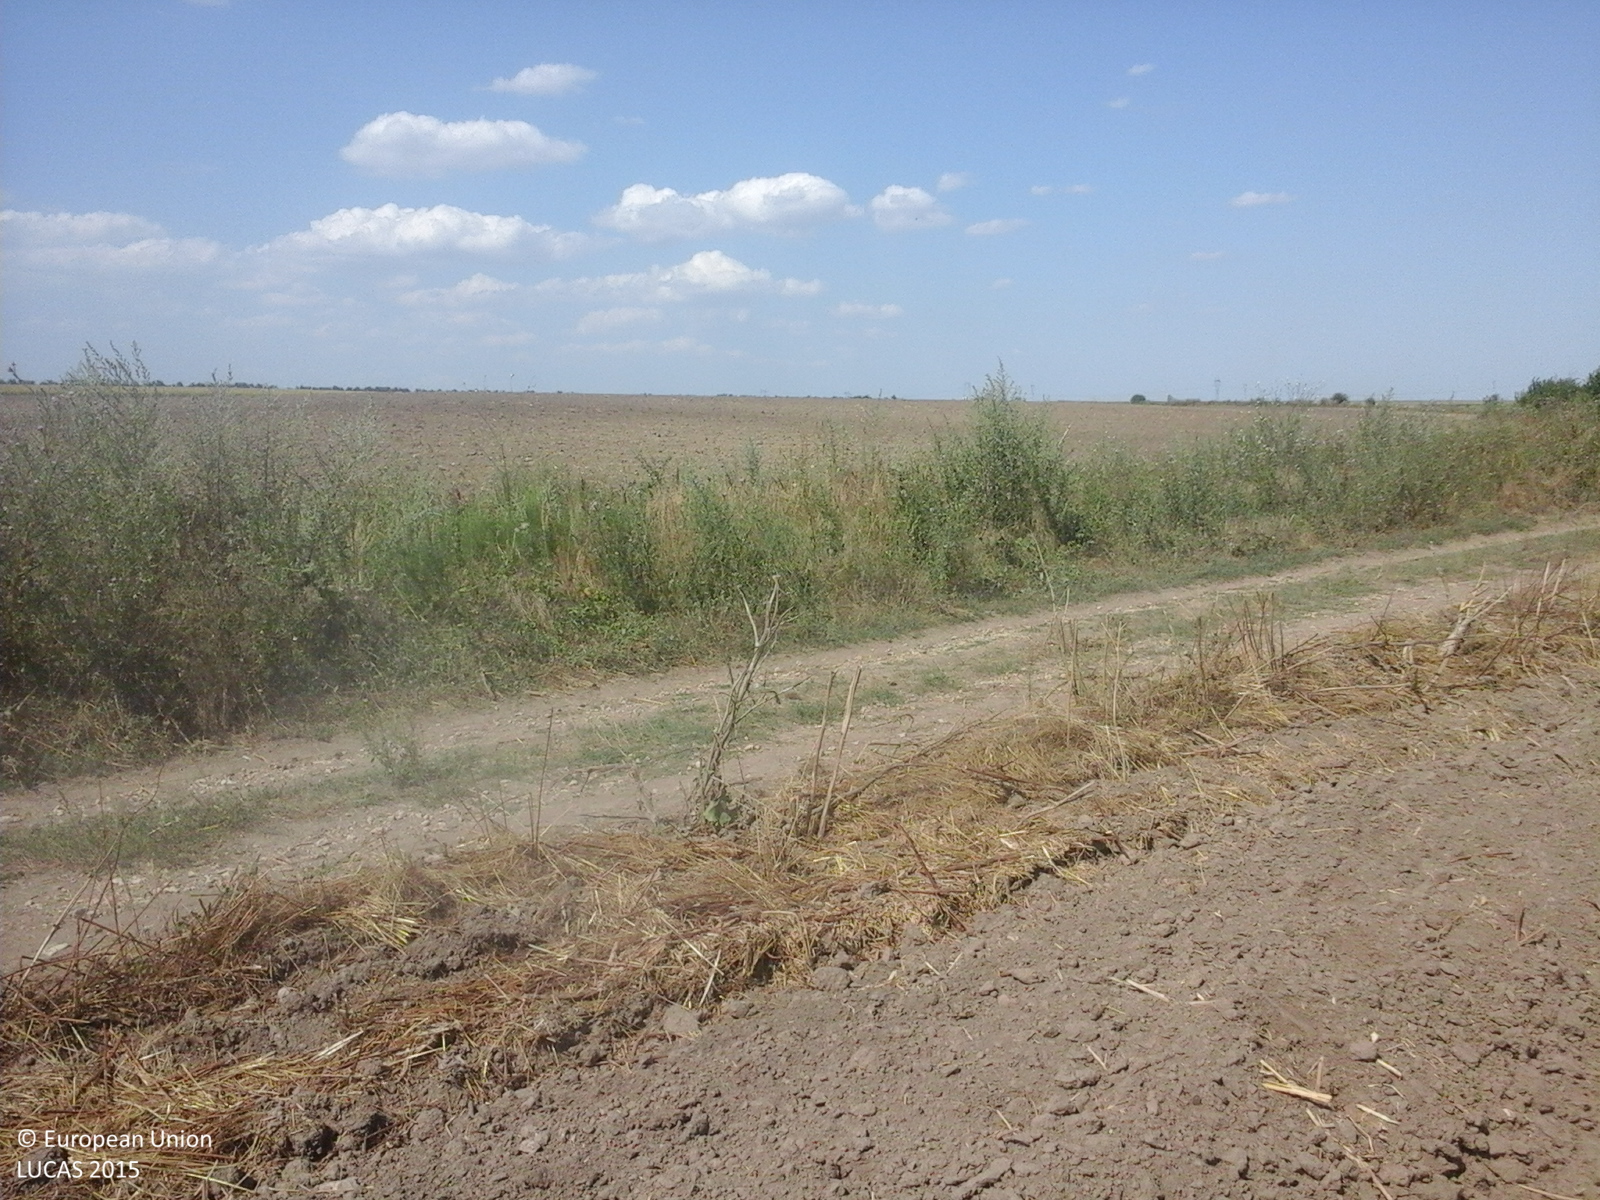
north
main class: Cropland
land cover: Rape and turnip rape
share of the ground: < 10 %
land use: Agriculture (excluding fallow land and kitchen gardens)
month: August
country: RO
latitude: 44.5549
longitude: 28.0747
